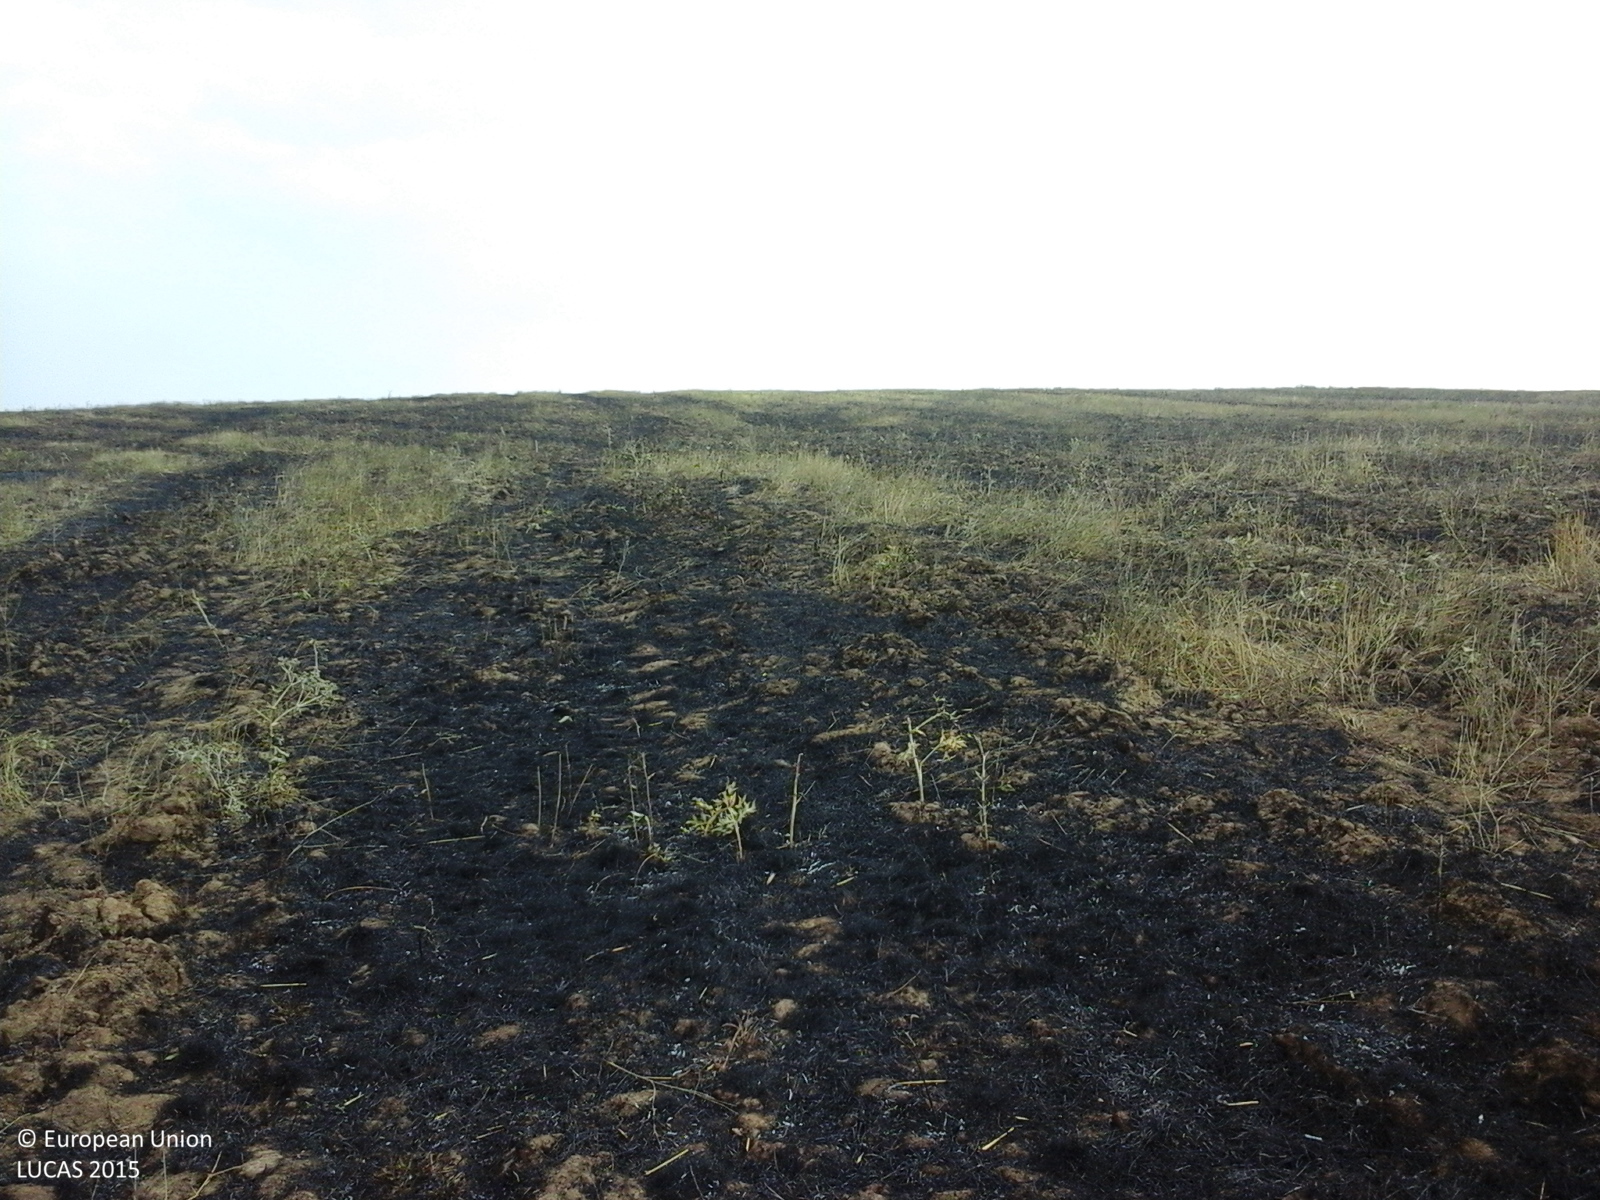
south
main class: Cropland
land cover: Durum wheat
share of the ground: 10 - 25 %
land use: Agriculture (excluding fallow land and kitchen gardens)
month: August
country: RO
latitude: 44.4529
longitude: 23.0526
